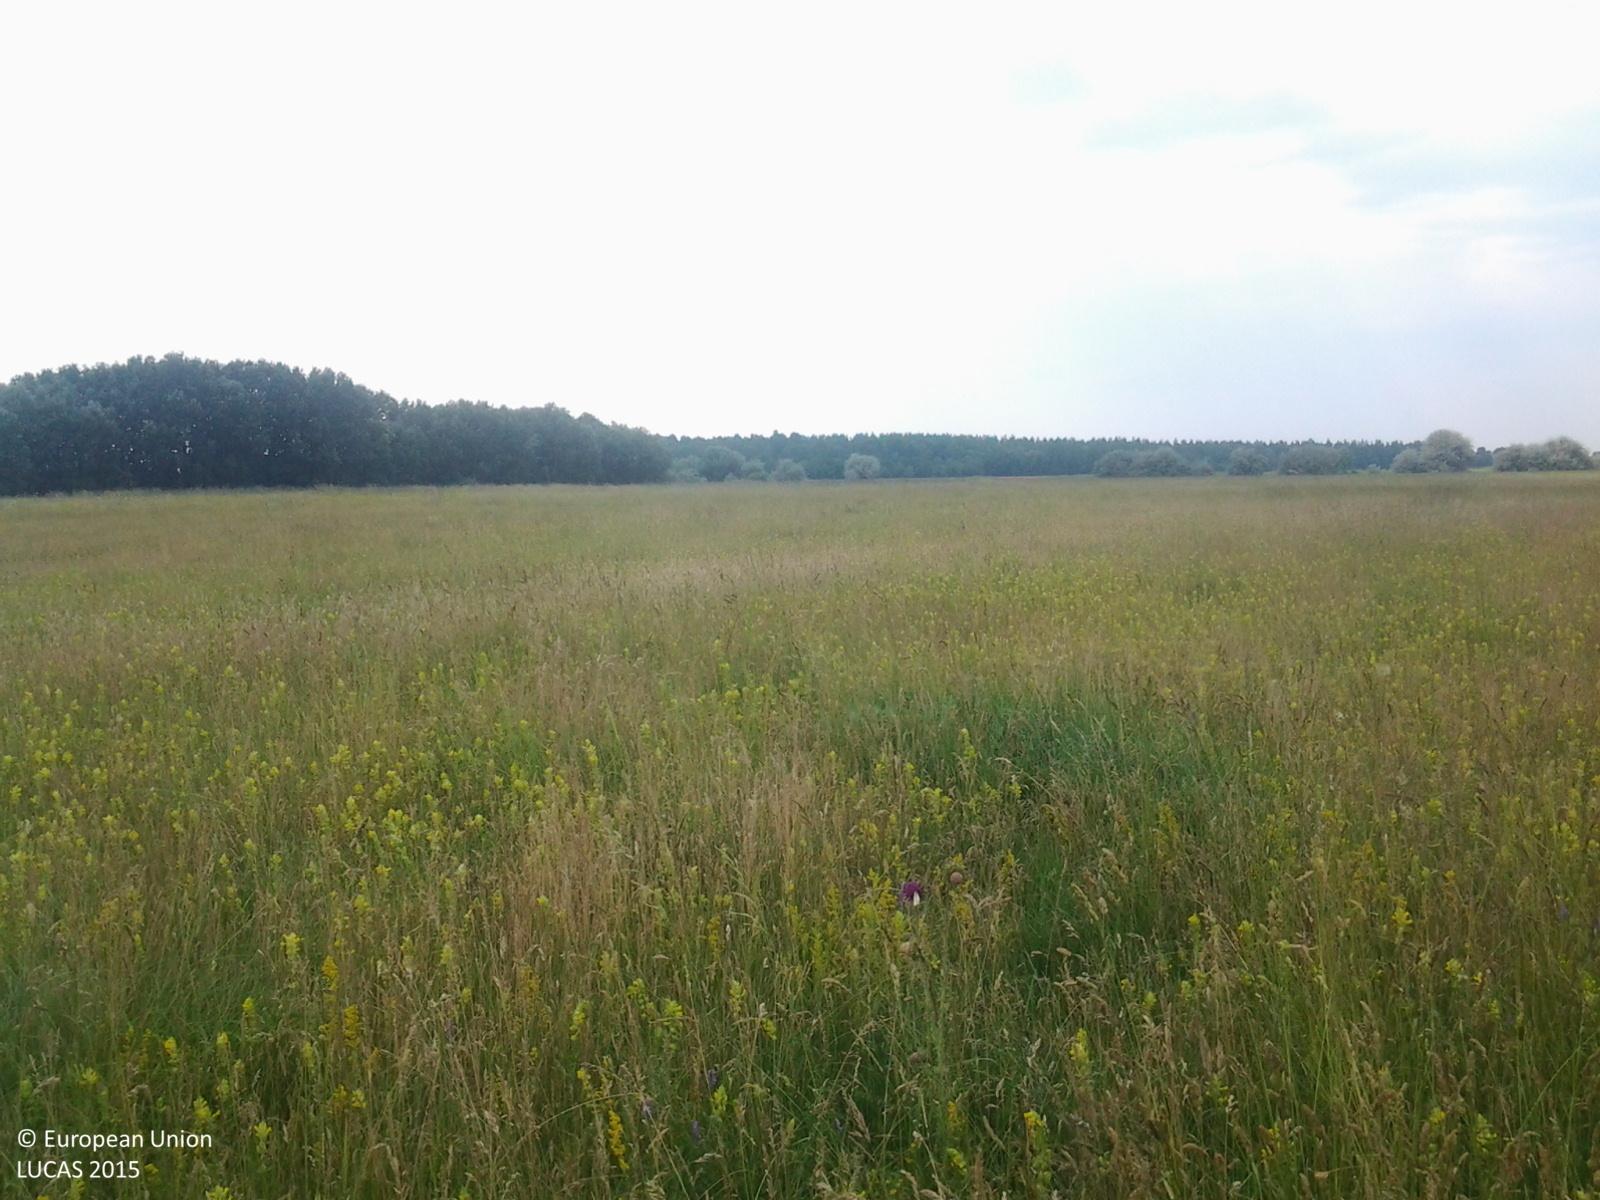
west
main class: Grassland
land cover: Grassland without tree/shrub cover
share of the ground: > 75 %
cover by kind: herbaceous plants 100 %
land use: Agriculture (excluding fallow land and kitchen gardens)
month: June
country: HU
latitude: 46.9177
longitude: 19.7779
